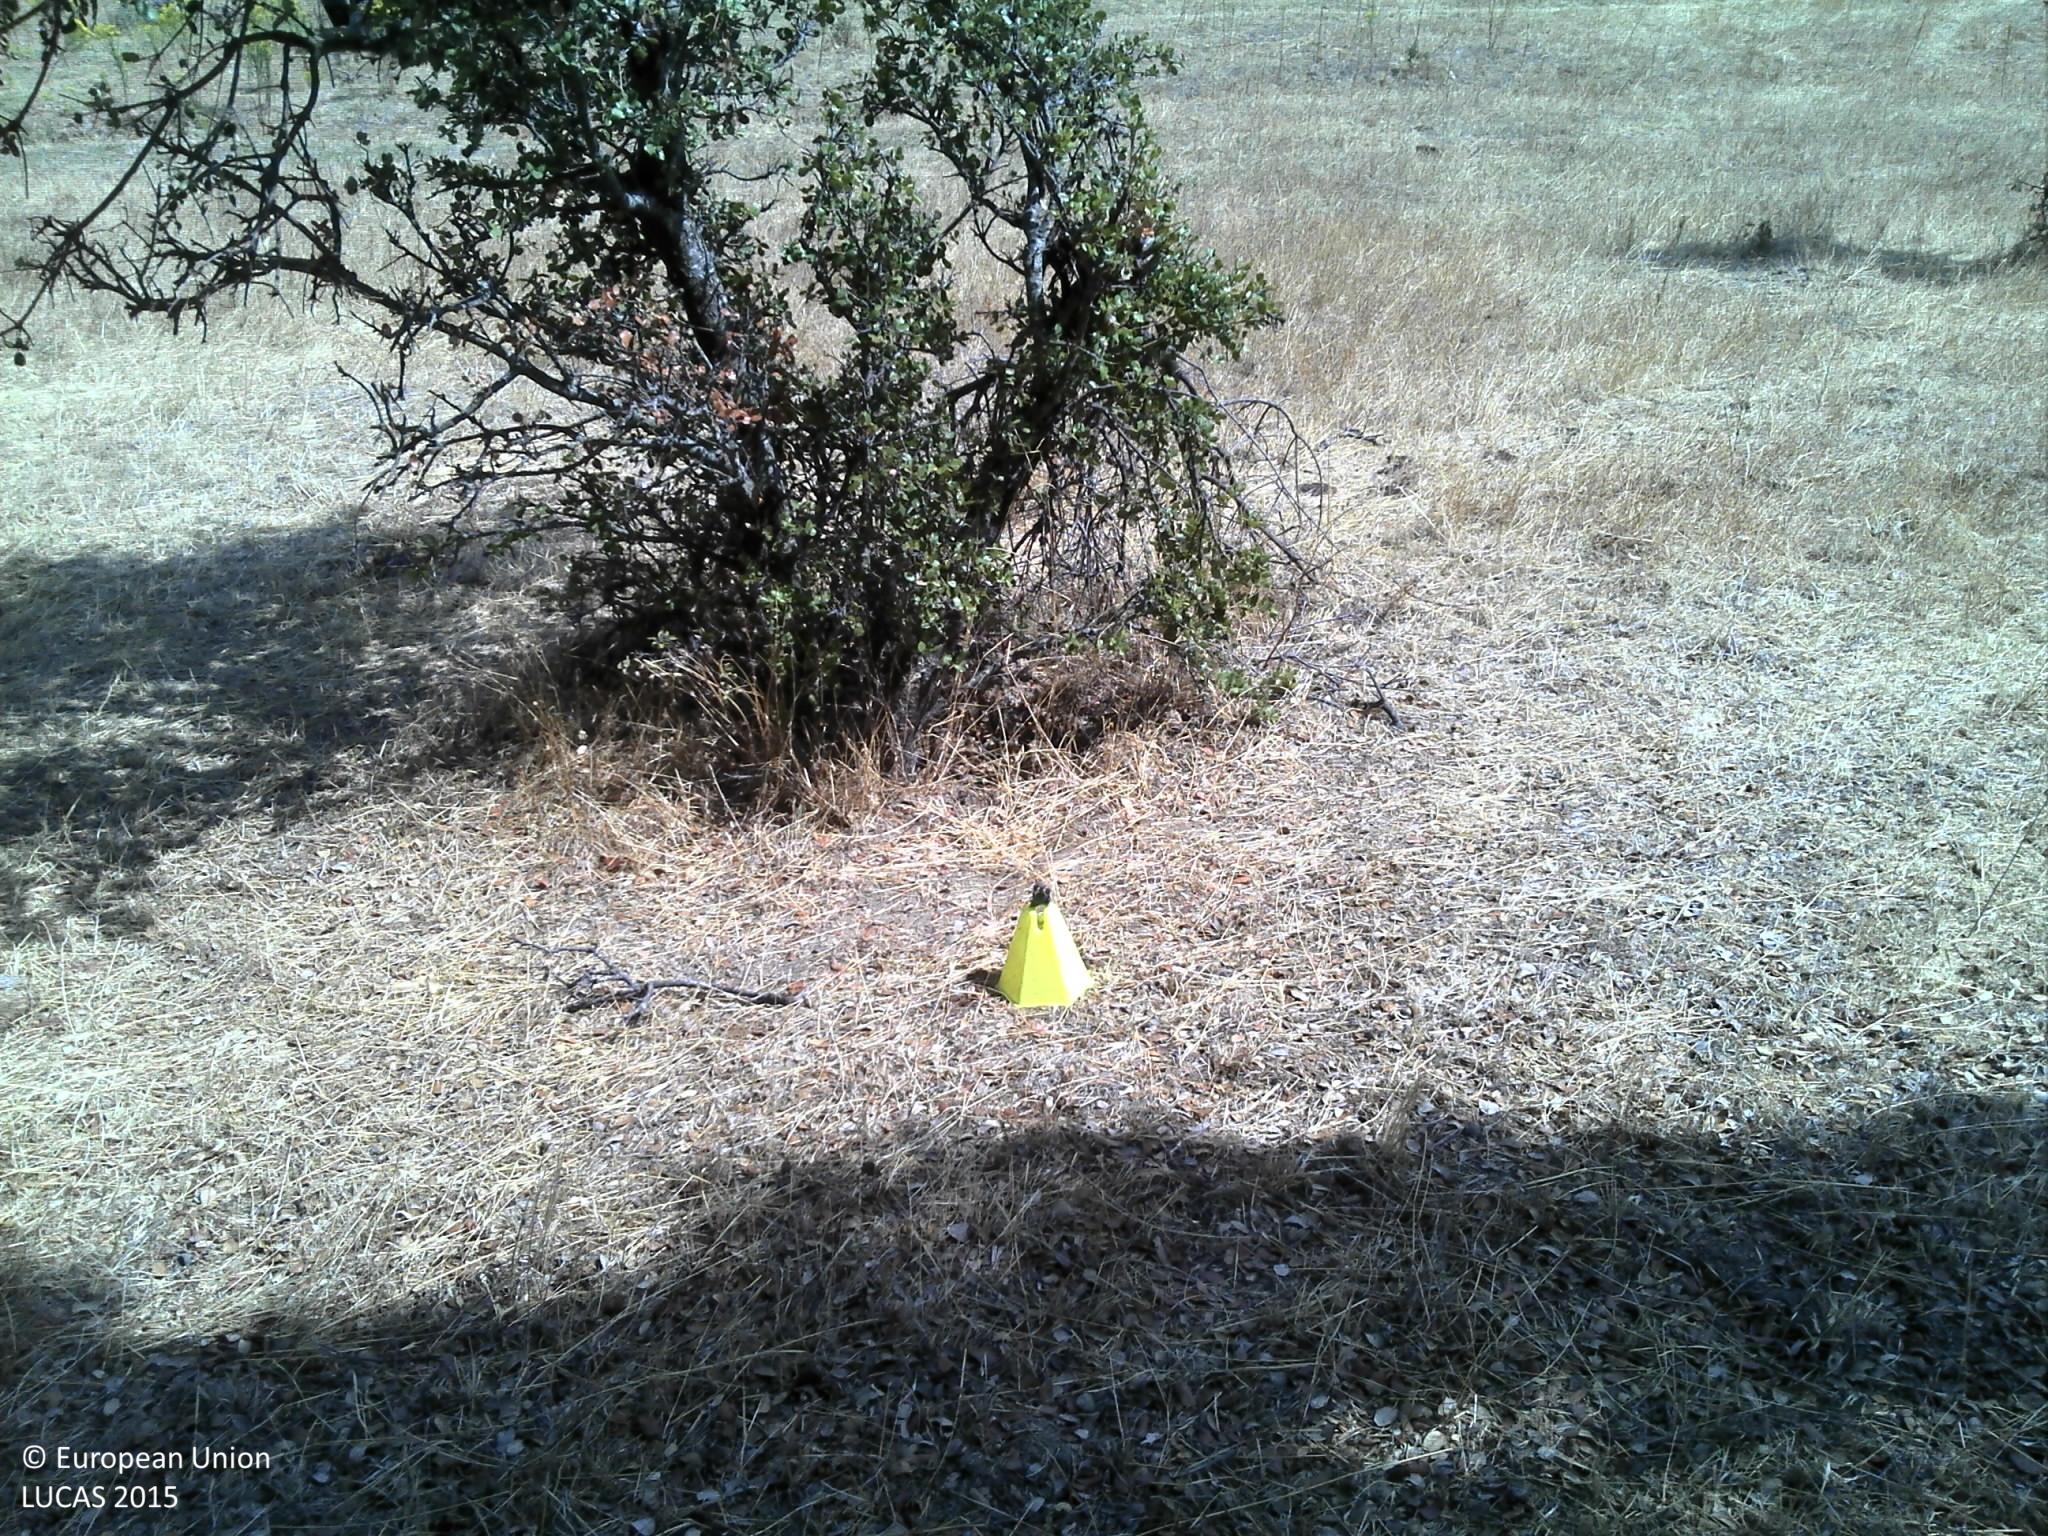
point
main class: Woodland
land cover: Broadleaved woodland
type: broadleaved evergreen forest
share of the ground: 10 - 25 %
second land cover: Grassland without tree/shrub cover
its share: 25 - 50 %
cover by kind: herbaceous plants 50 %, unconsolidated bare surface 40 %, broadleaved forest trees 10 %
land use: Forestry
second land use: Agriculture (excluding fallow land and kitchen gardens)
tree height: > 5 m
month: July
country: PT
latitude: 38.7634
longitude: -7.3502
